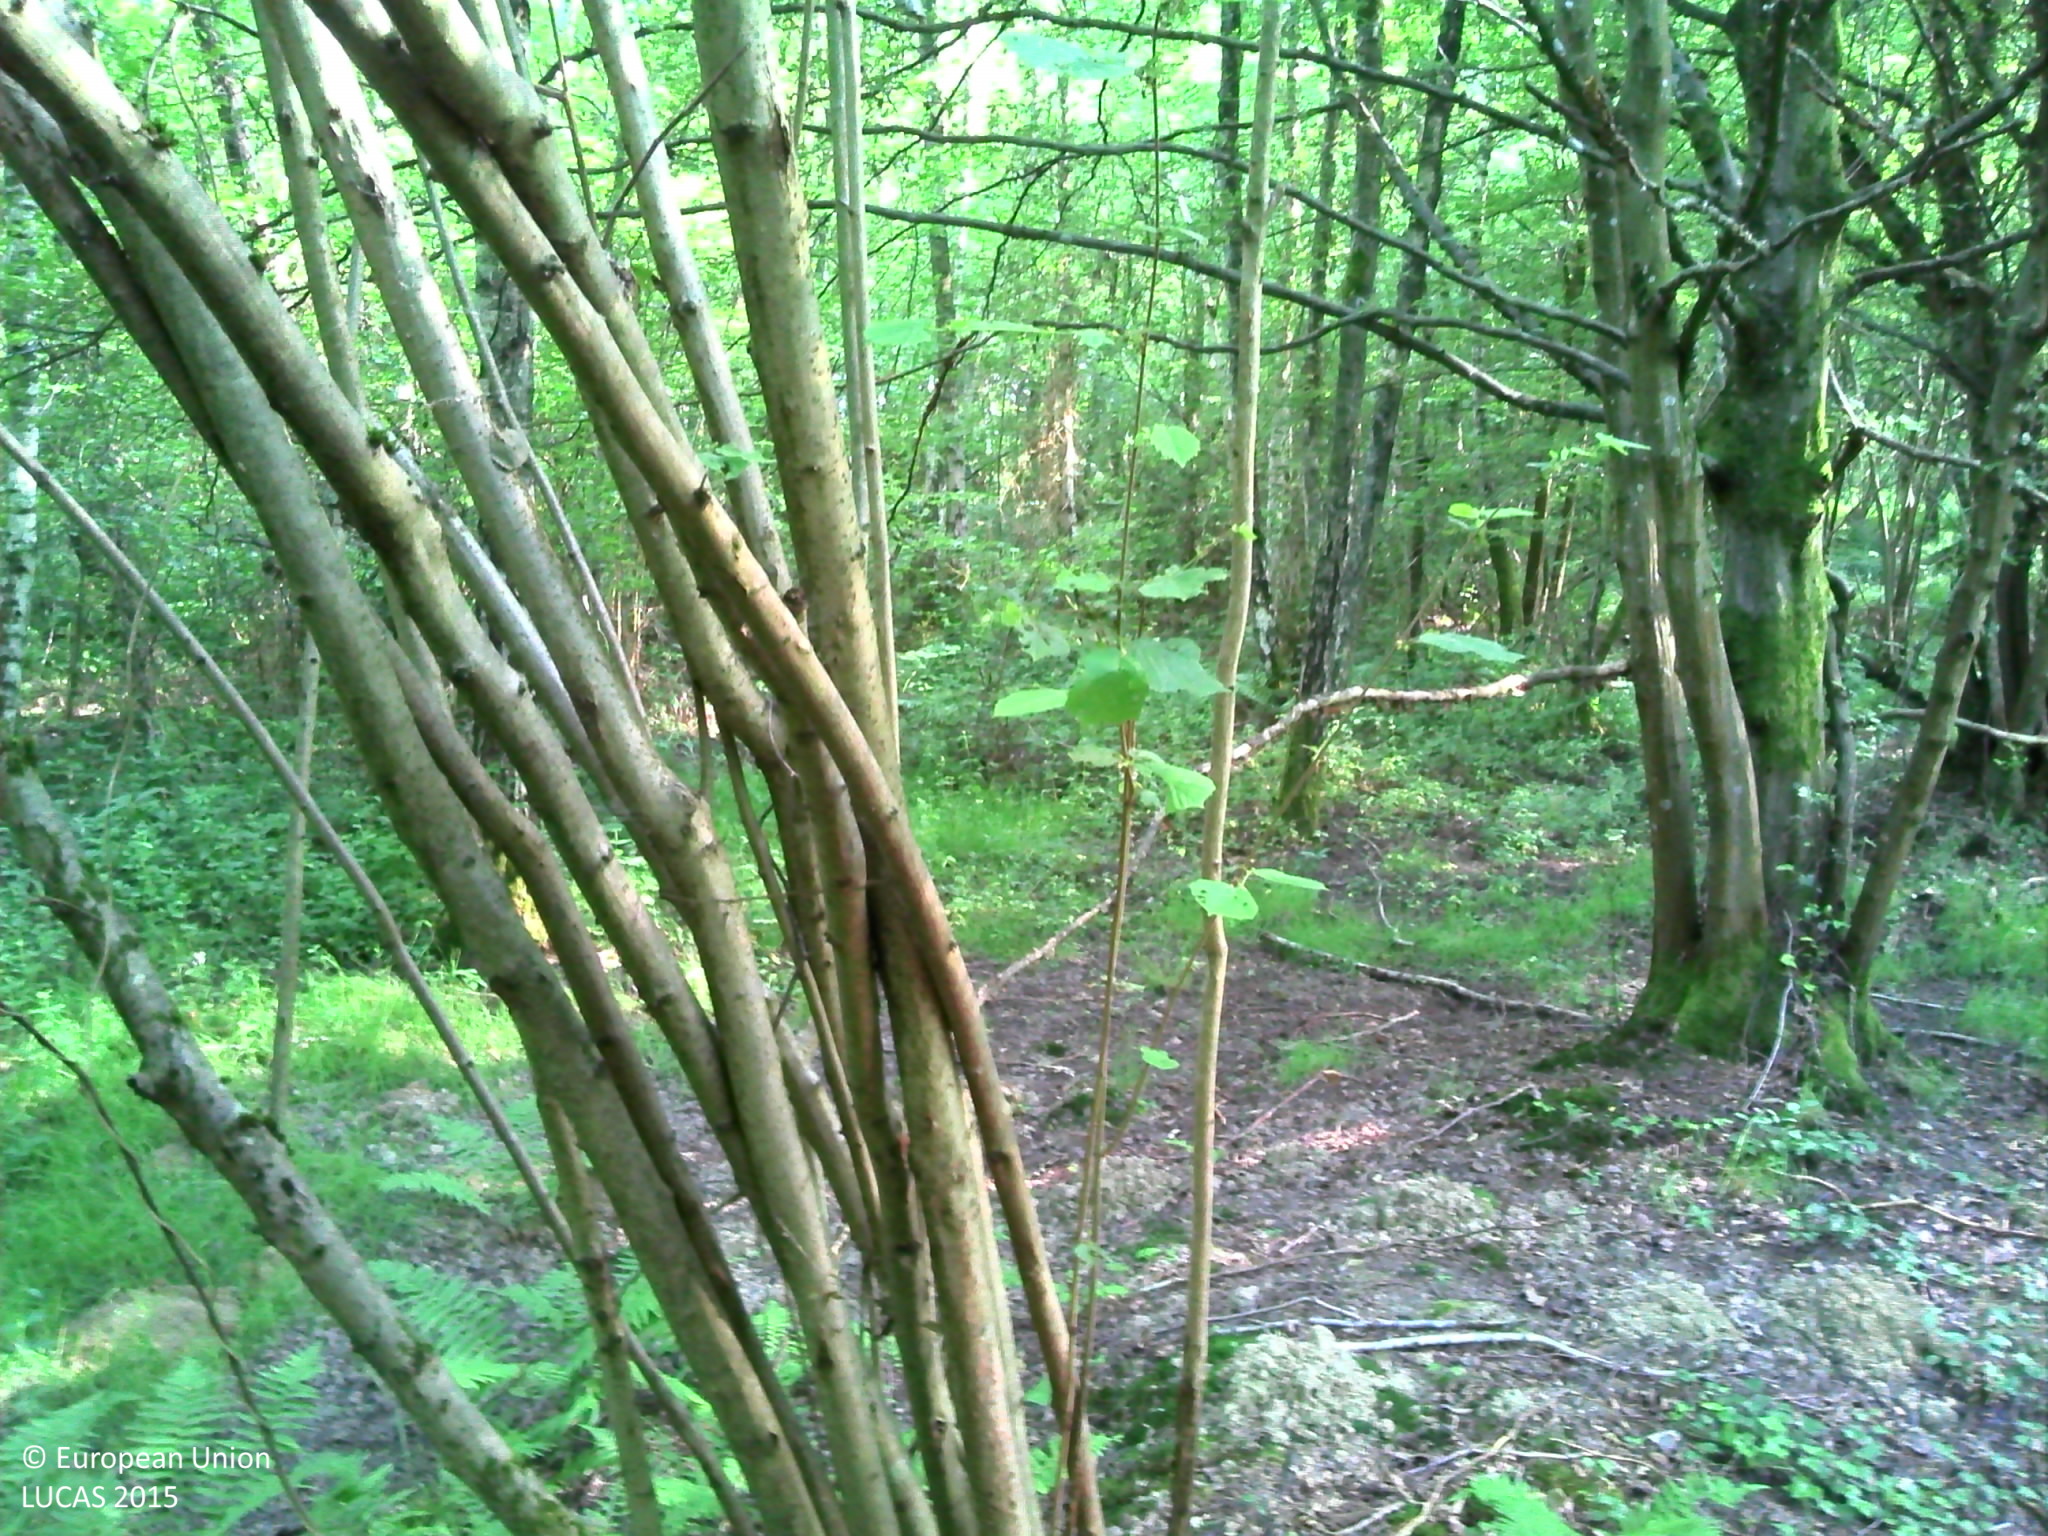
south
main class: Woodland
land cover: Broadleaved woodland
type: mesophytic deciduous forest
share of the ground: > 75 %
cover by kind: broadleaved forest trees 80 %, herbaceous plants 20 %
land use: Forestry
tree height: > 5 m
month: June
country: FR
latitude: 45.9245
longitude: 4.9356
